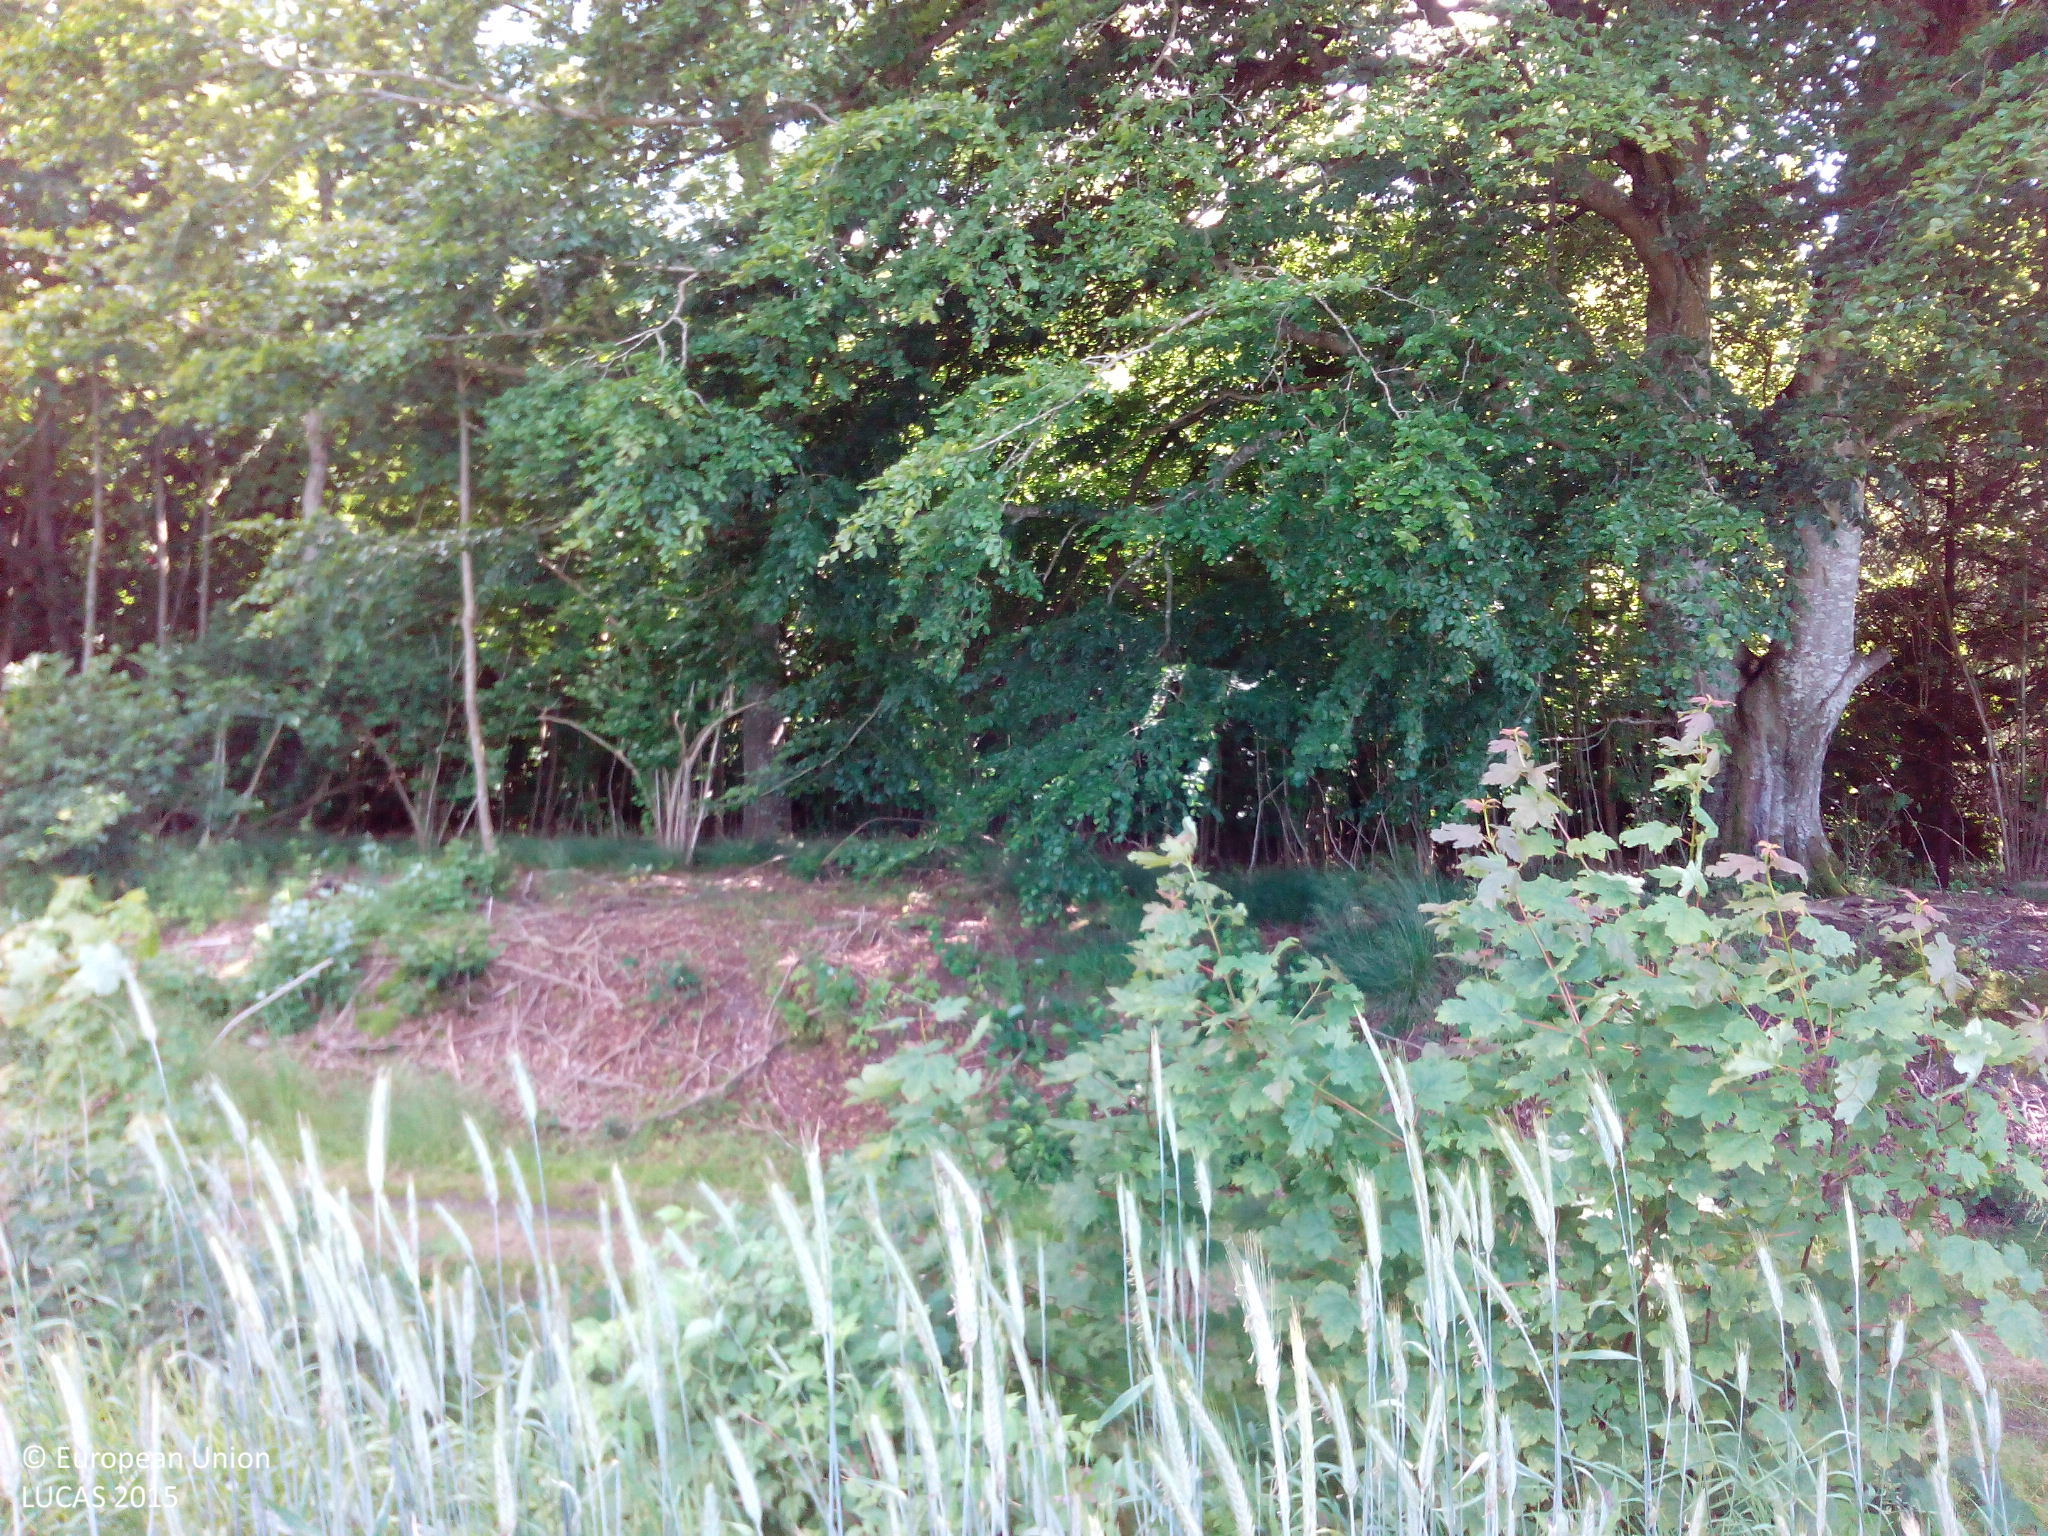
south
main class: Cropland
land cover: Rye
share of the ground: > 75 %
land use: Agriculture (excluding fallow land and kitchen gardens)
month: June
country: DK
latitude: 56.3291
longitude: 10.7915
